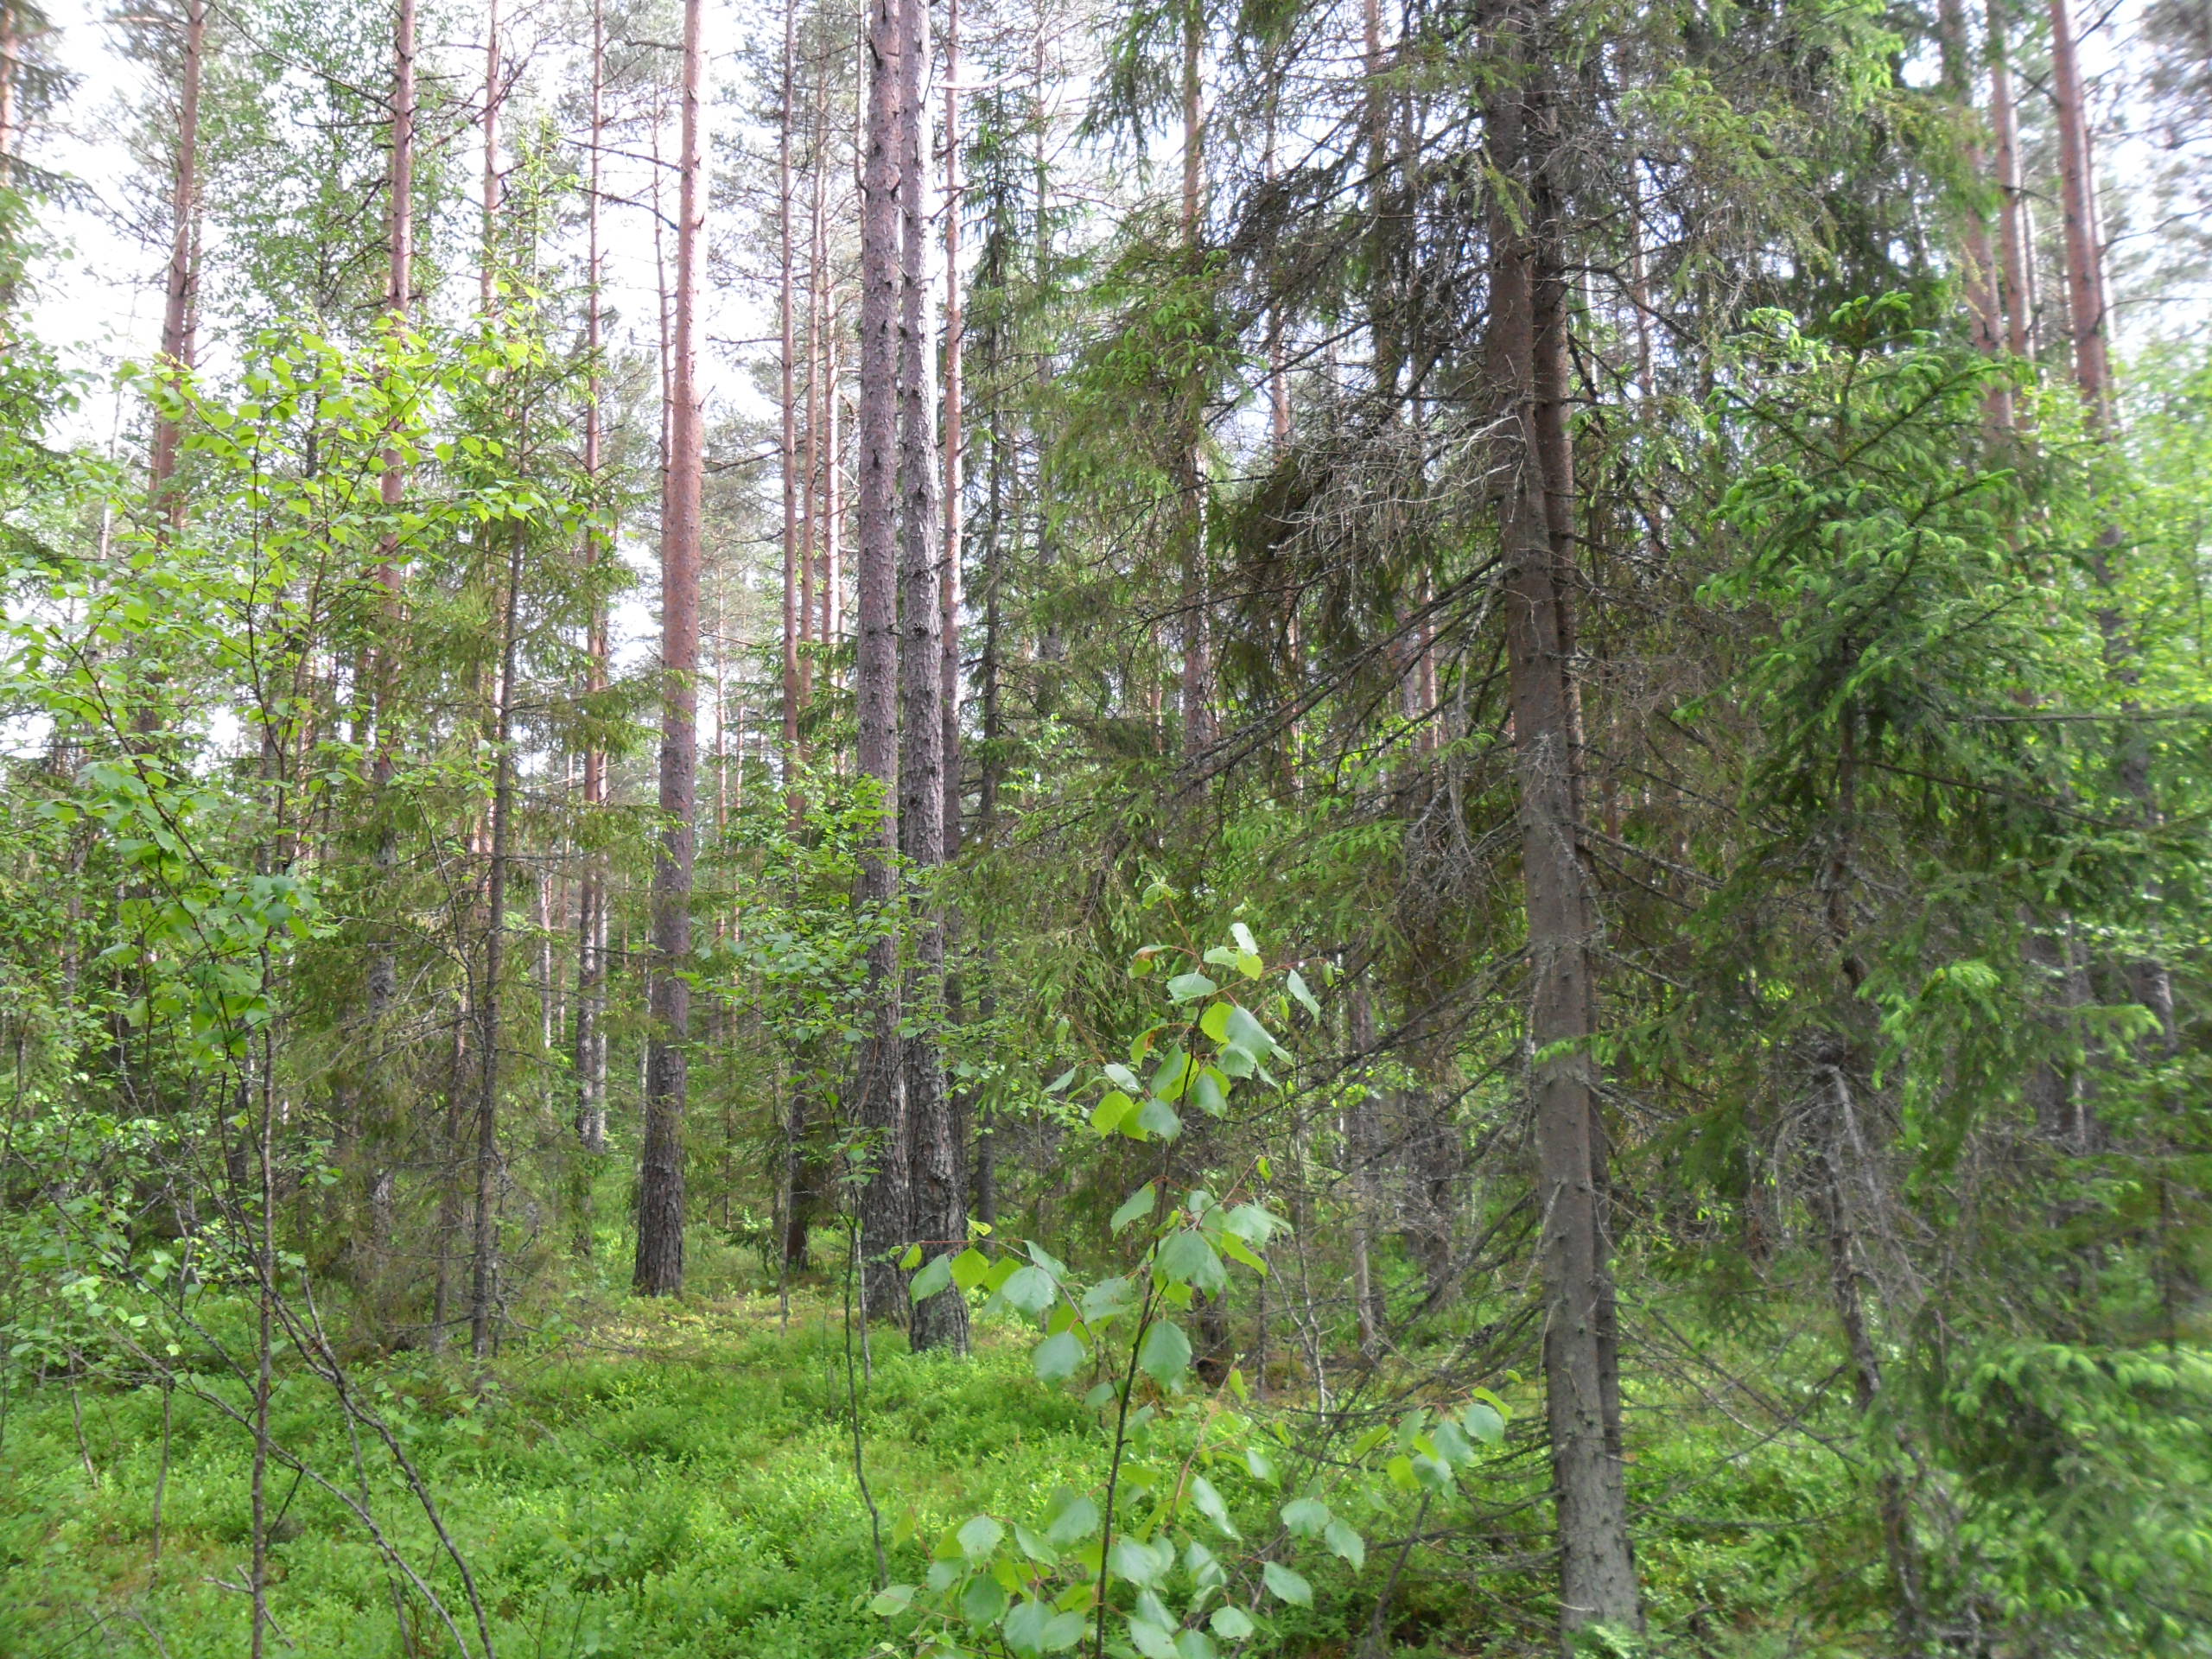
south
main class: Woodland
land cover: Other coniferous woodland
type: hemiboreal forest and nemoral coniferous forest and mixed broadleaved-coniferous forest
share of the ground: > 75 %
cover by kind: coniferous forest trees 70 %, herbaceous plants 20 %, broadleaved forest trees 5 %, lichens and mosses 5 %
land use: Forestry
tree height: > 5 m
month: June
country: LV
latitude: 57.4961
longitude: 22.2119
